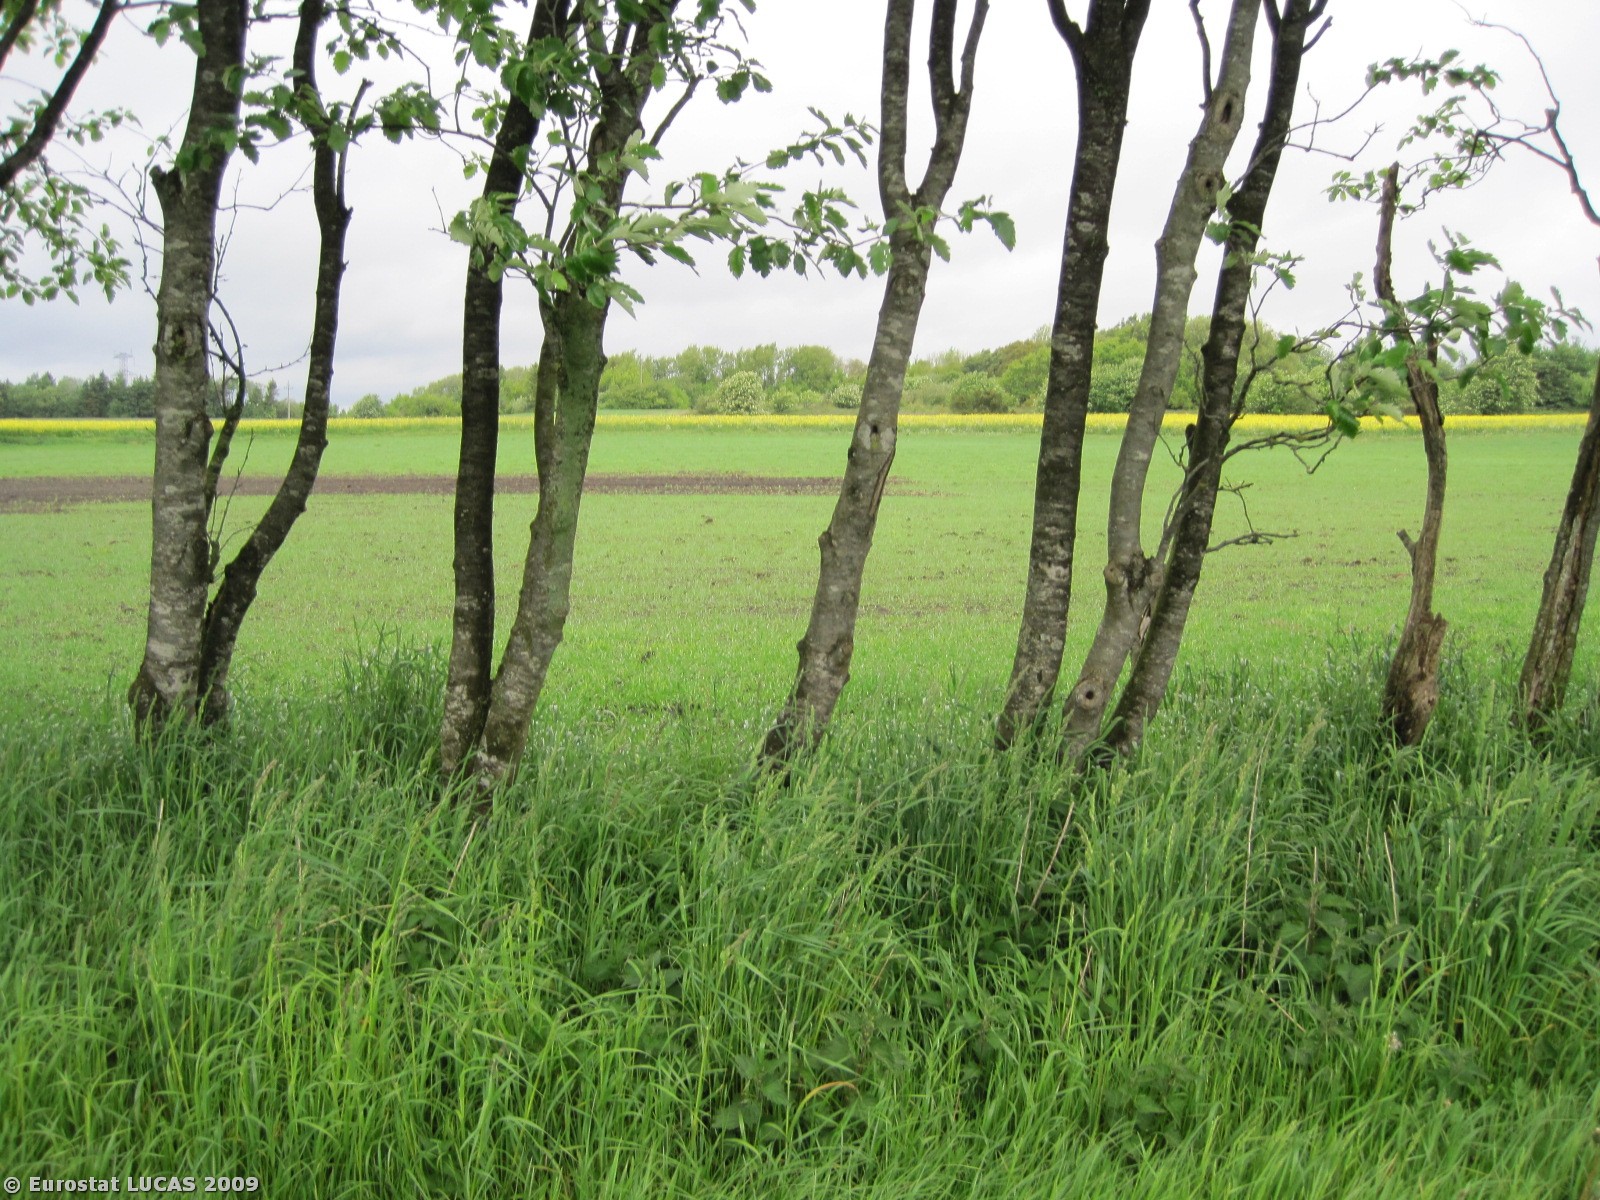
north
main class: Grassland
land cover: Grassland without tree/shrub cover
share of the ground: > 75 %
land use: Agriculture (excluding fallow land and kitchen gardens)
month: May
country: DK
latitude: 56.8347
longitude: 9.7545
